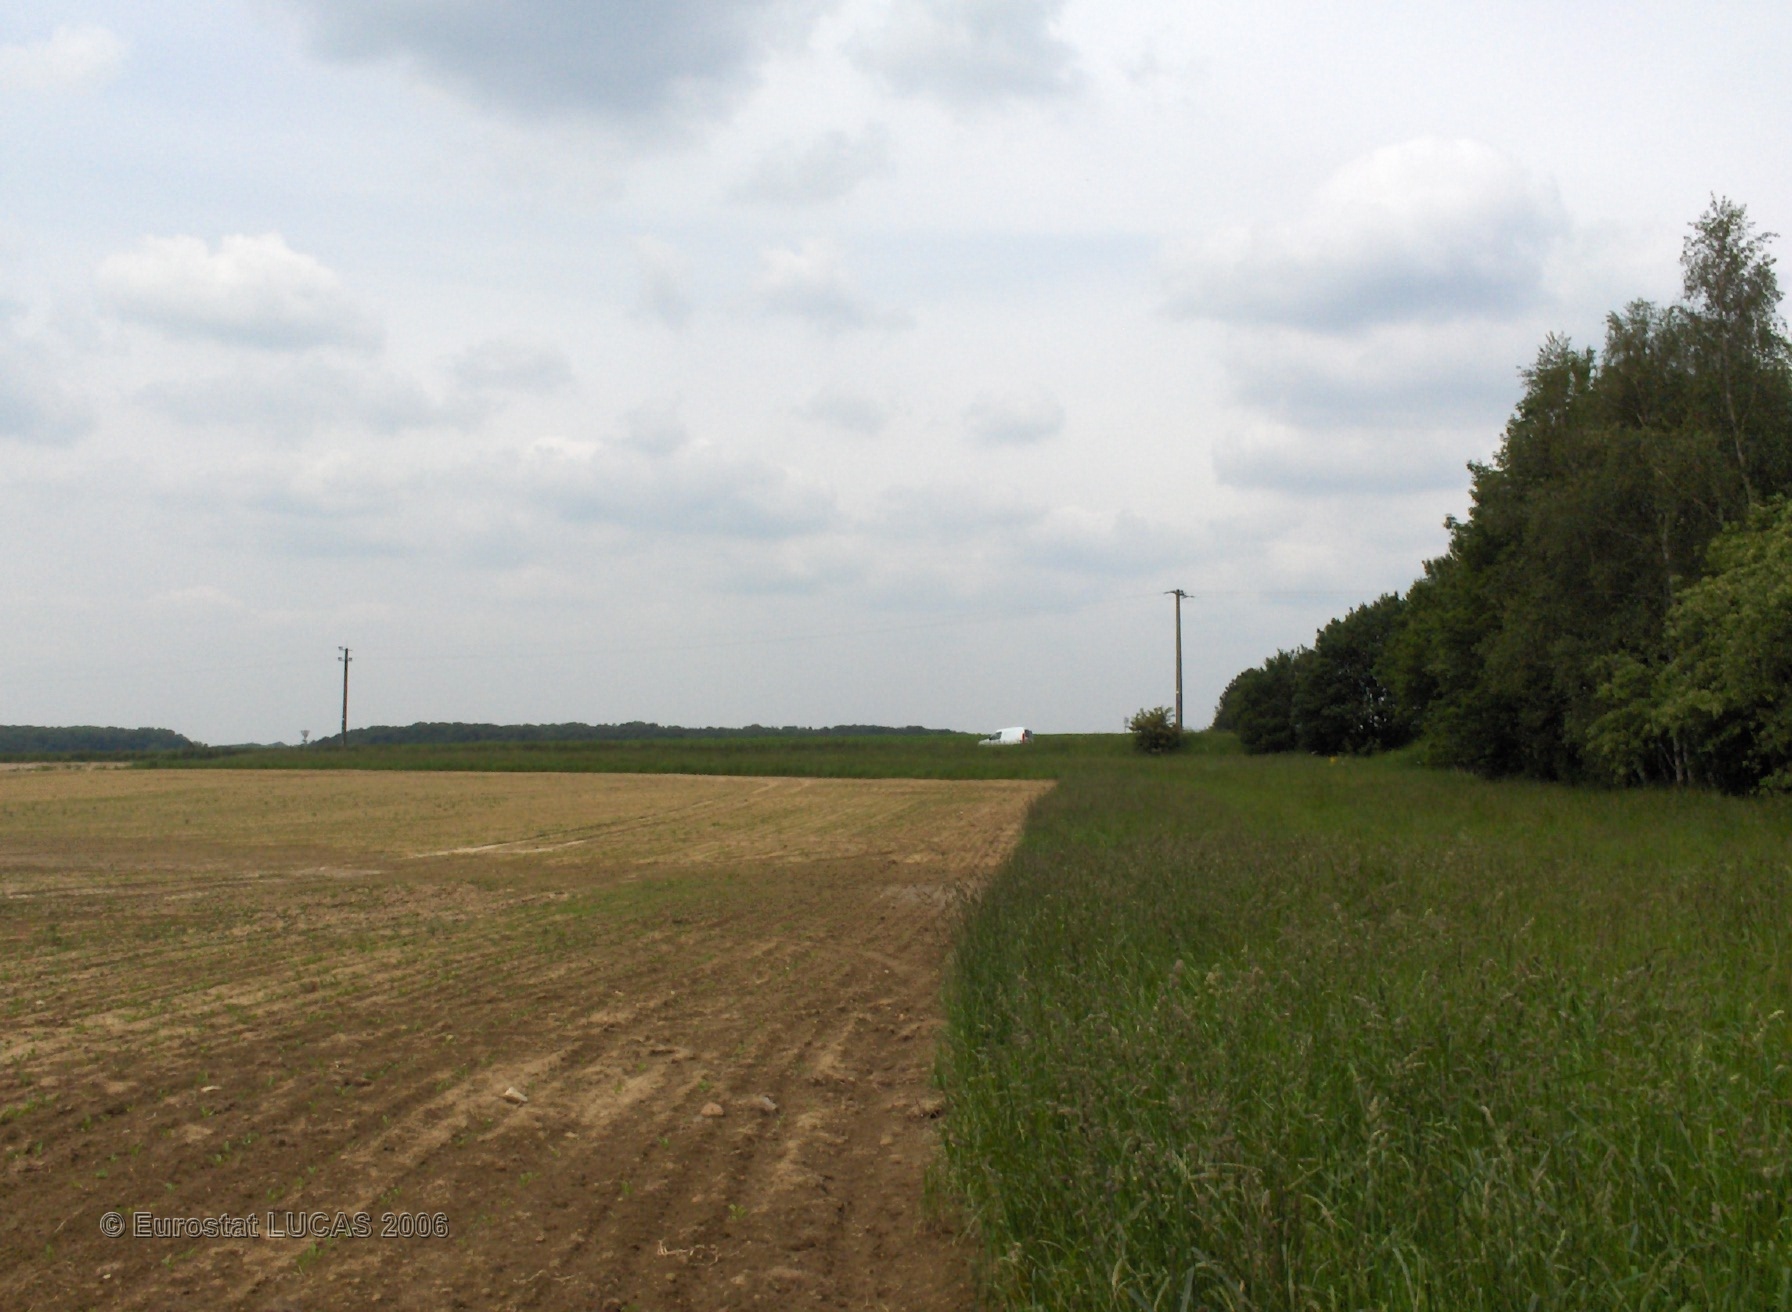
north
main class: Grassland
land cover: Grassland without tree/shrub cover
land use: Agriculture (excluding fallow land and kitchen gardens)
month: June
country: BE
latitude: 50.2146
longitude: 4.5166
